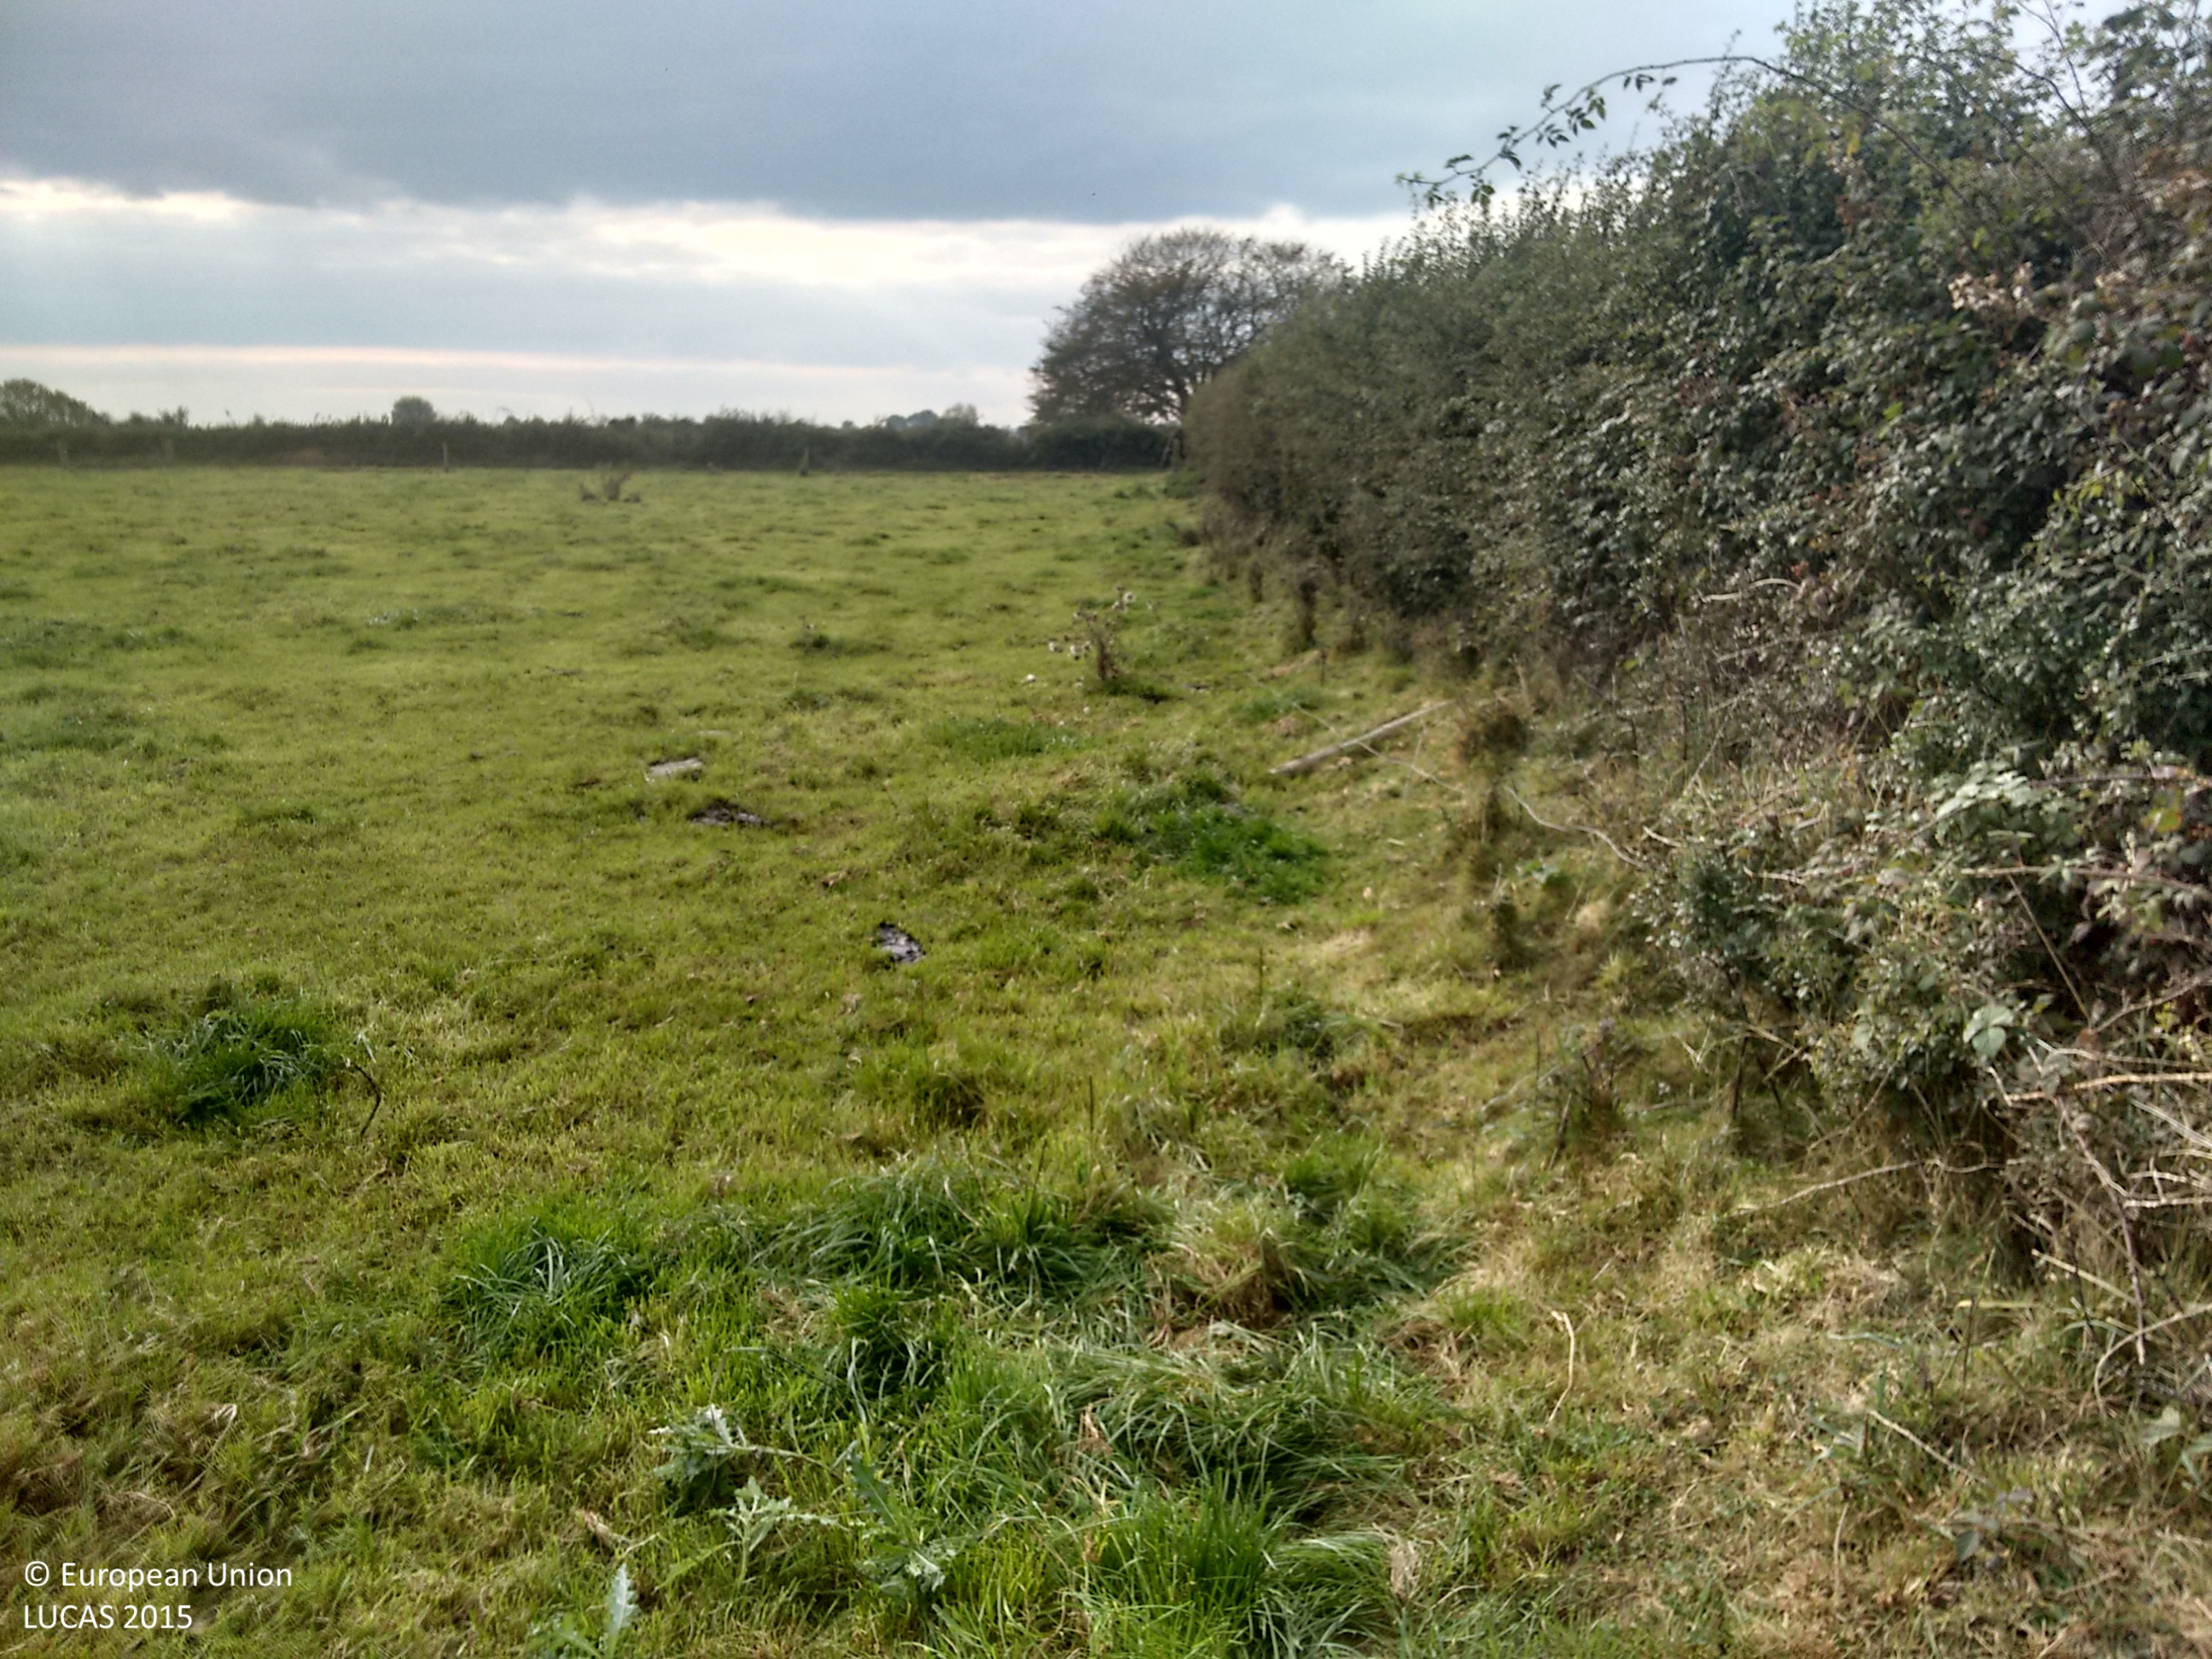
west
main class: Grassland
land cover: Grassland without tree/shrub cover
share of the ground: > 75 %
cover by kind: herbaceous plants 95 %, shrubs 5 %
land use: Agriculture (excluding fallow land and kitchen gardens)
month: October
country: IE
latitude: 52.8776
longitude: -7.5601
